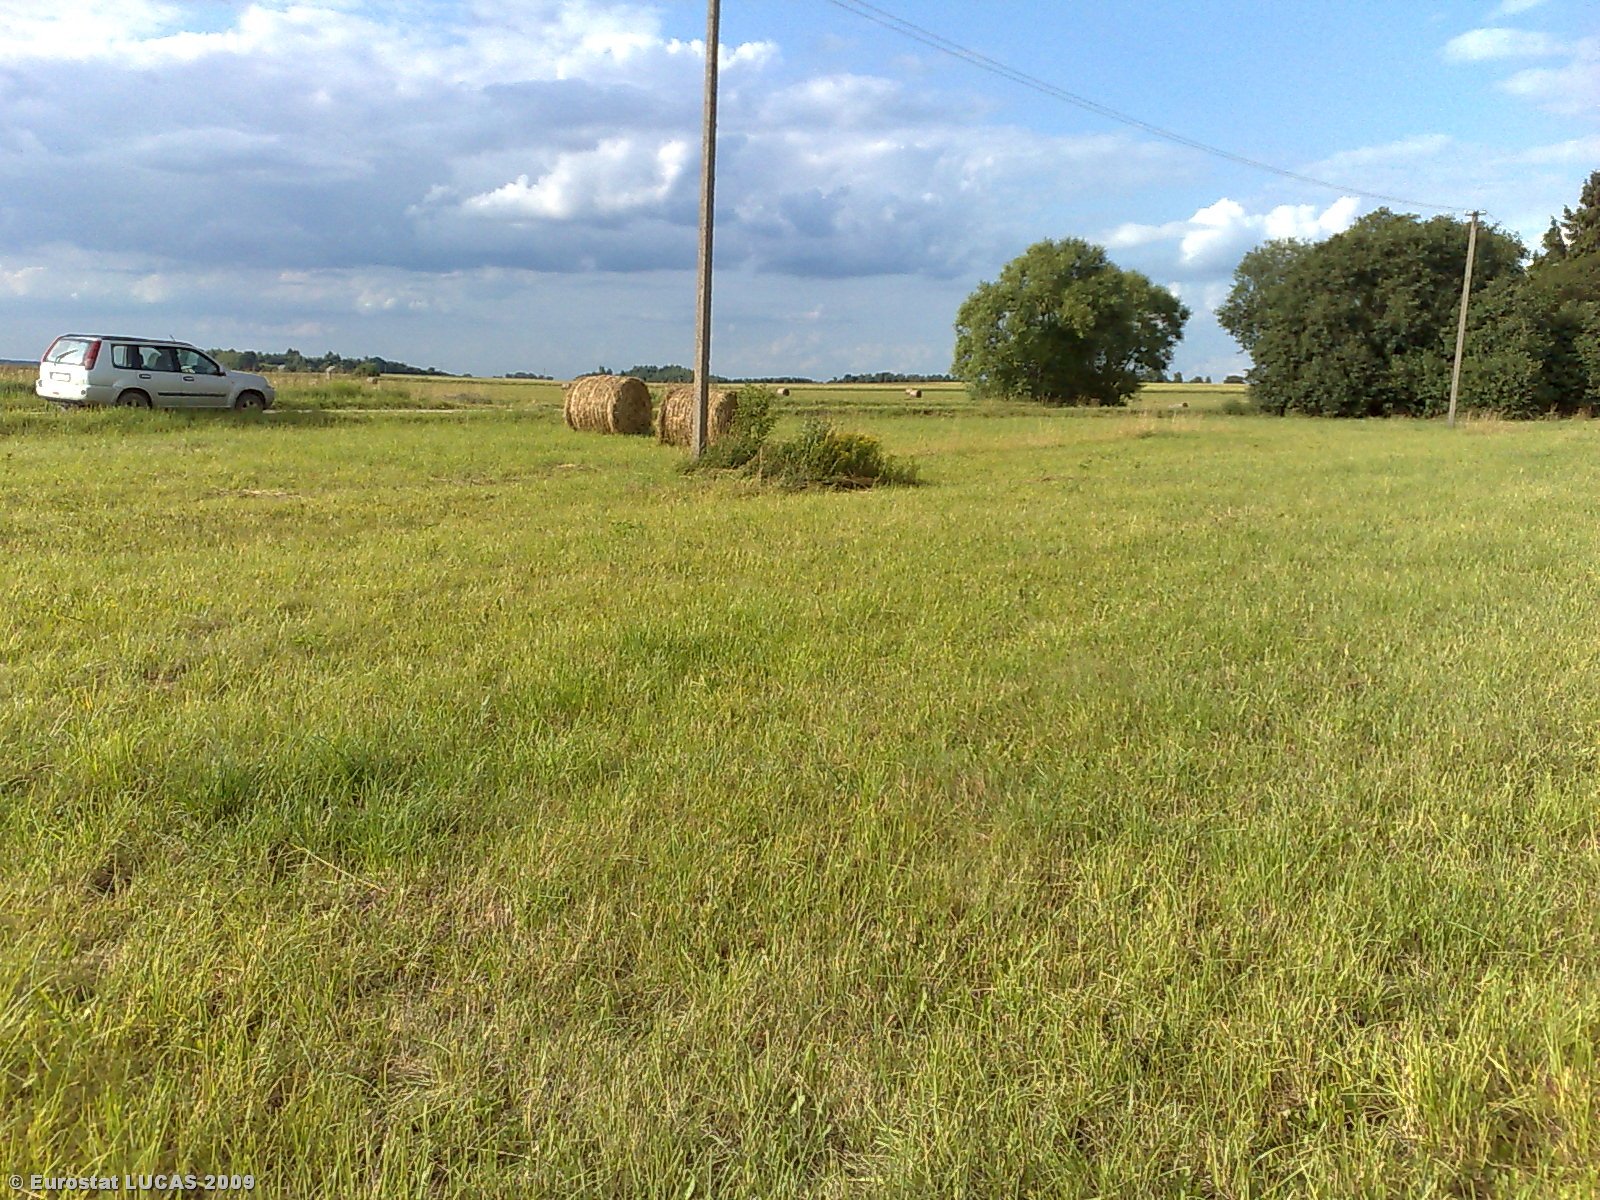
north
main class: Grassland
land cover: Grassland without tree/shrub cover
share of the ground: > 75 %
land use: Agriculture (excluding fallow land and kitchen gardens)
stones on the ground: < 10 %
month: July
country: LT
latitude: 55.7269
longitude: 22.7872
